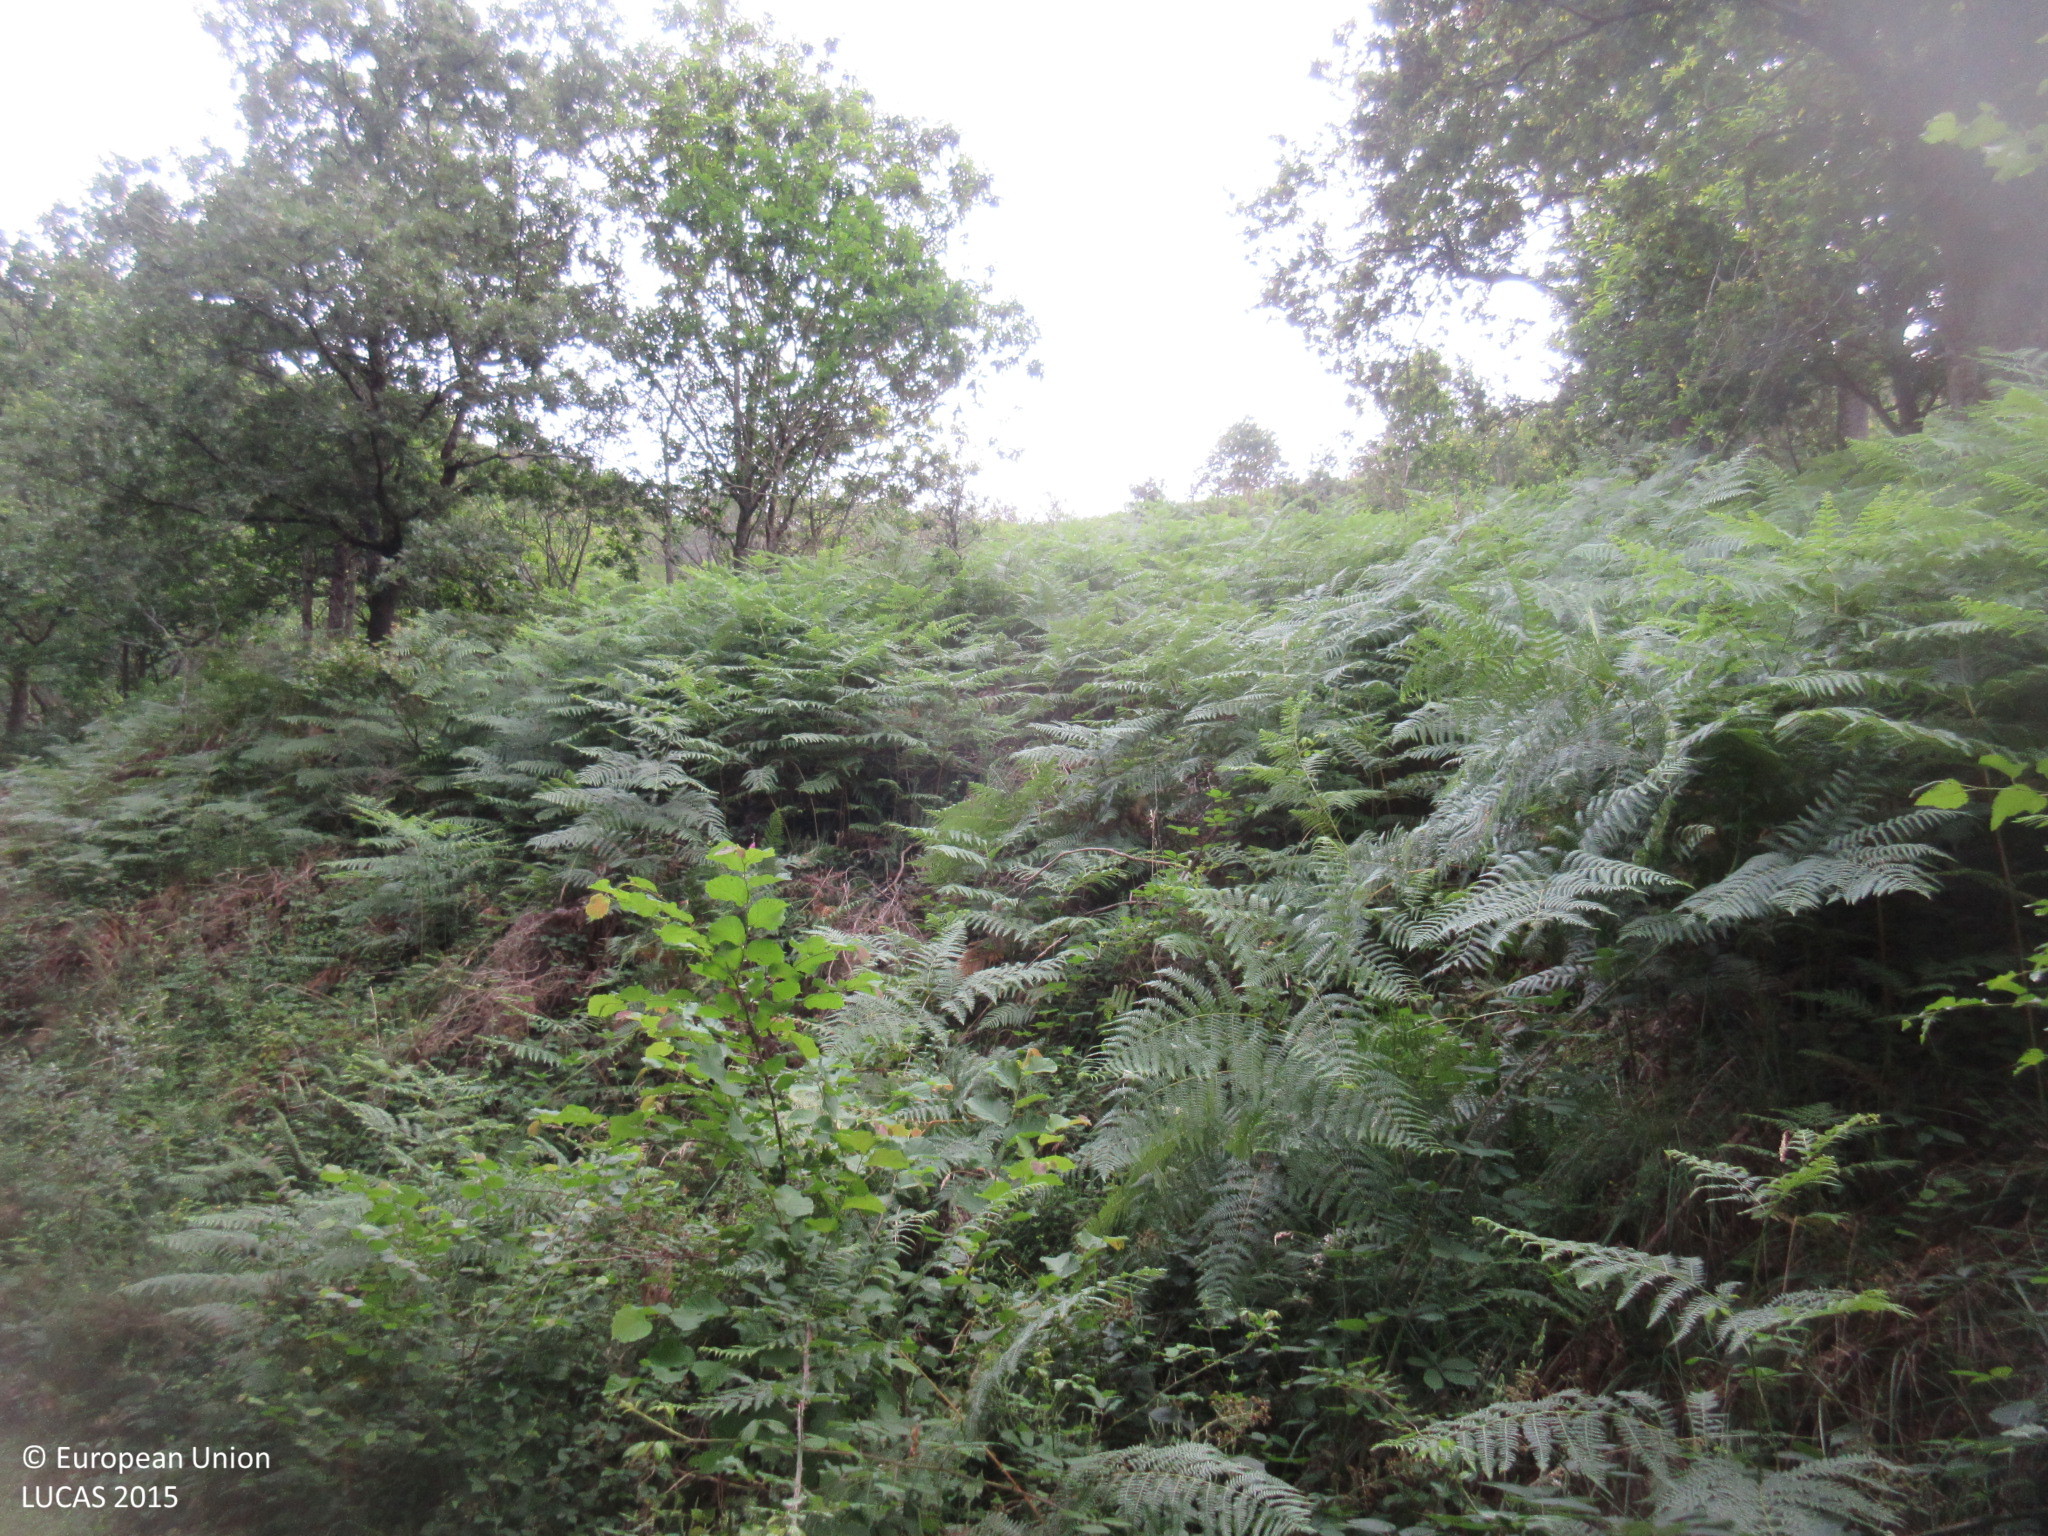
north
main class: Shrubland
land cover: Shrubland without tree cover
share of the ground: > 75 %
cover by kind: shrubs 100 %
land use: Semi-natural and natural areas not in use
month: July
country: ES
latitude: 43.2827
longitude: -3.4872
